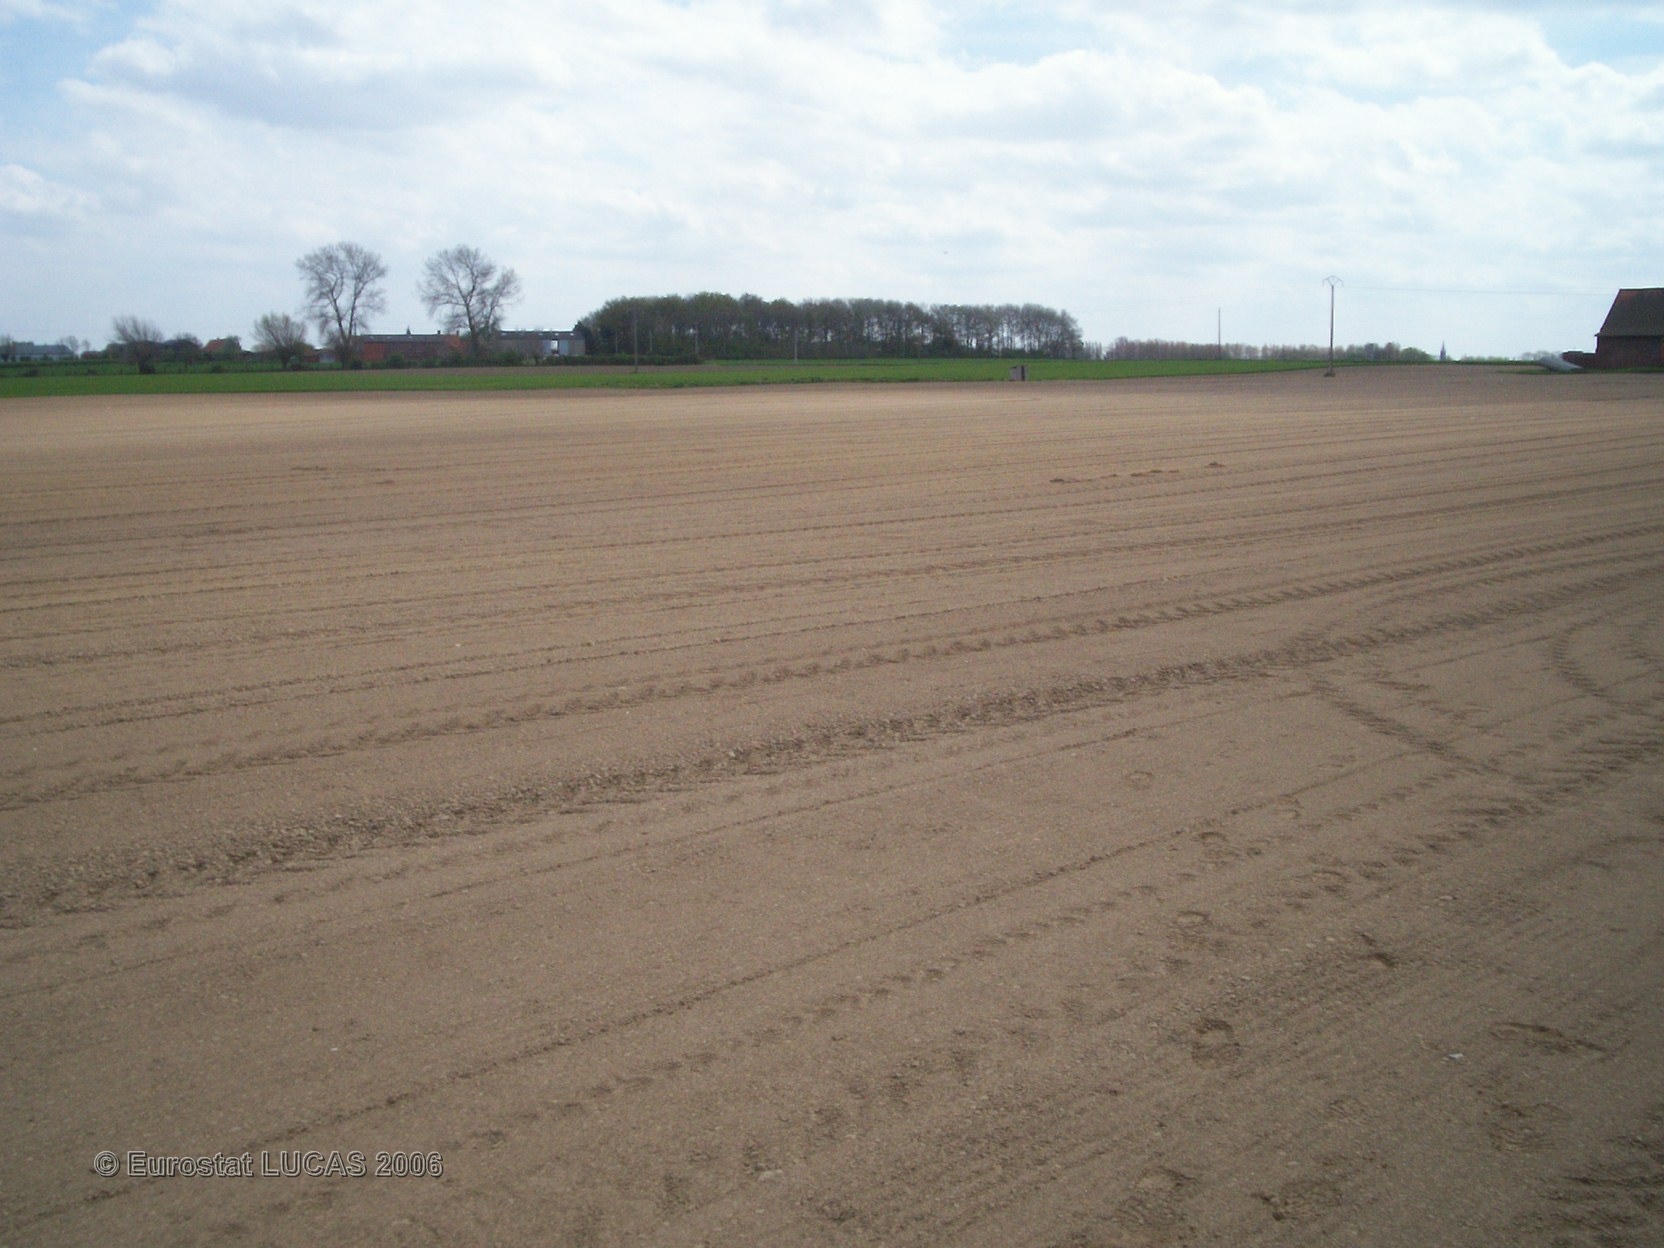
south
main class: Cropland
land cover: Other fresh vegetables
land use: Agriculture (excluding fallow land and kitchen gardens)
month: June
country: FR
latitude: 50.8618
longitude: 2.5571
